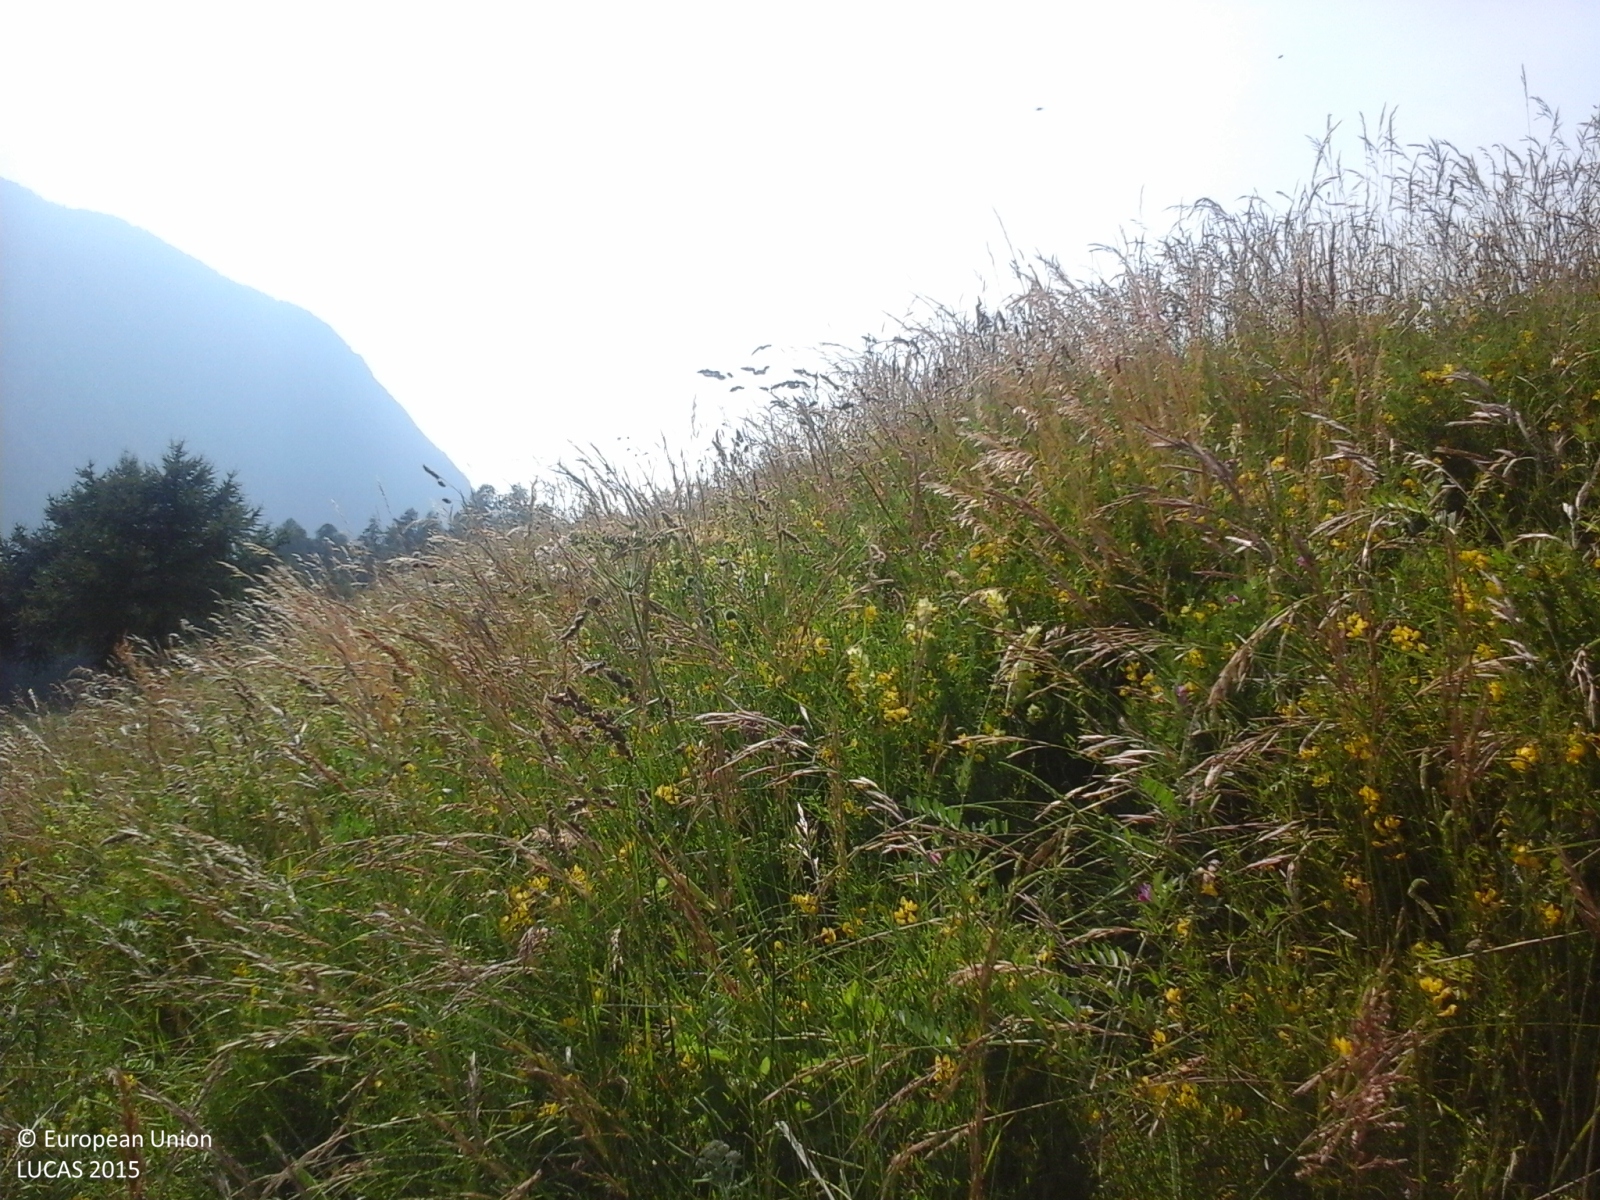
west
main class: Grassland
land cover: Grassland without tree/shrub cover
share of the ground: > 75 %
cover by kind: herbaceous plants 100 %
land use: Agriculture (excluding fallow land and kitchen gardens)
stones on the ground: < 10 %
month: July
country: IT
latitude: 45.7509
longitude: 7.7536
